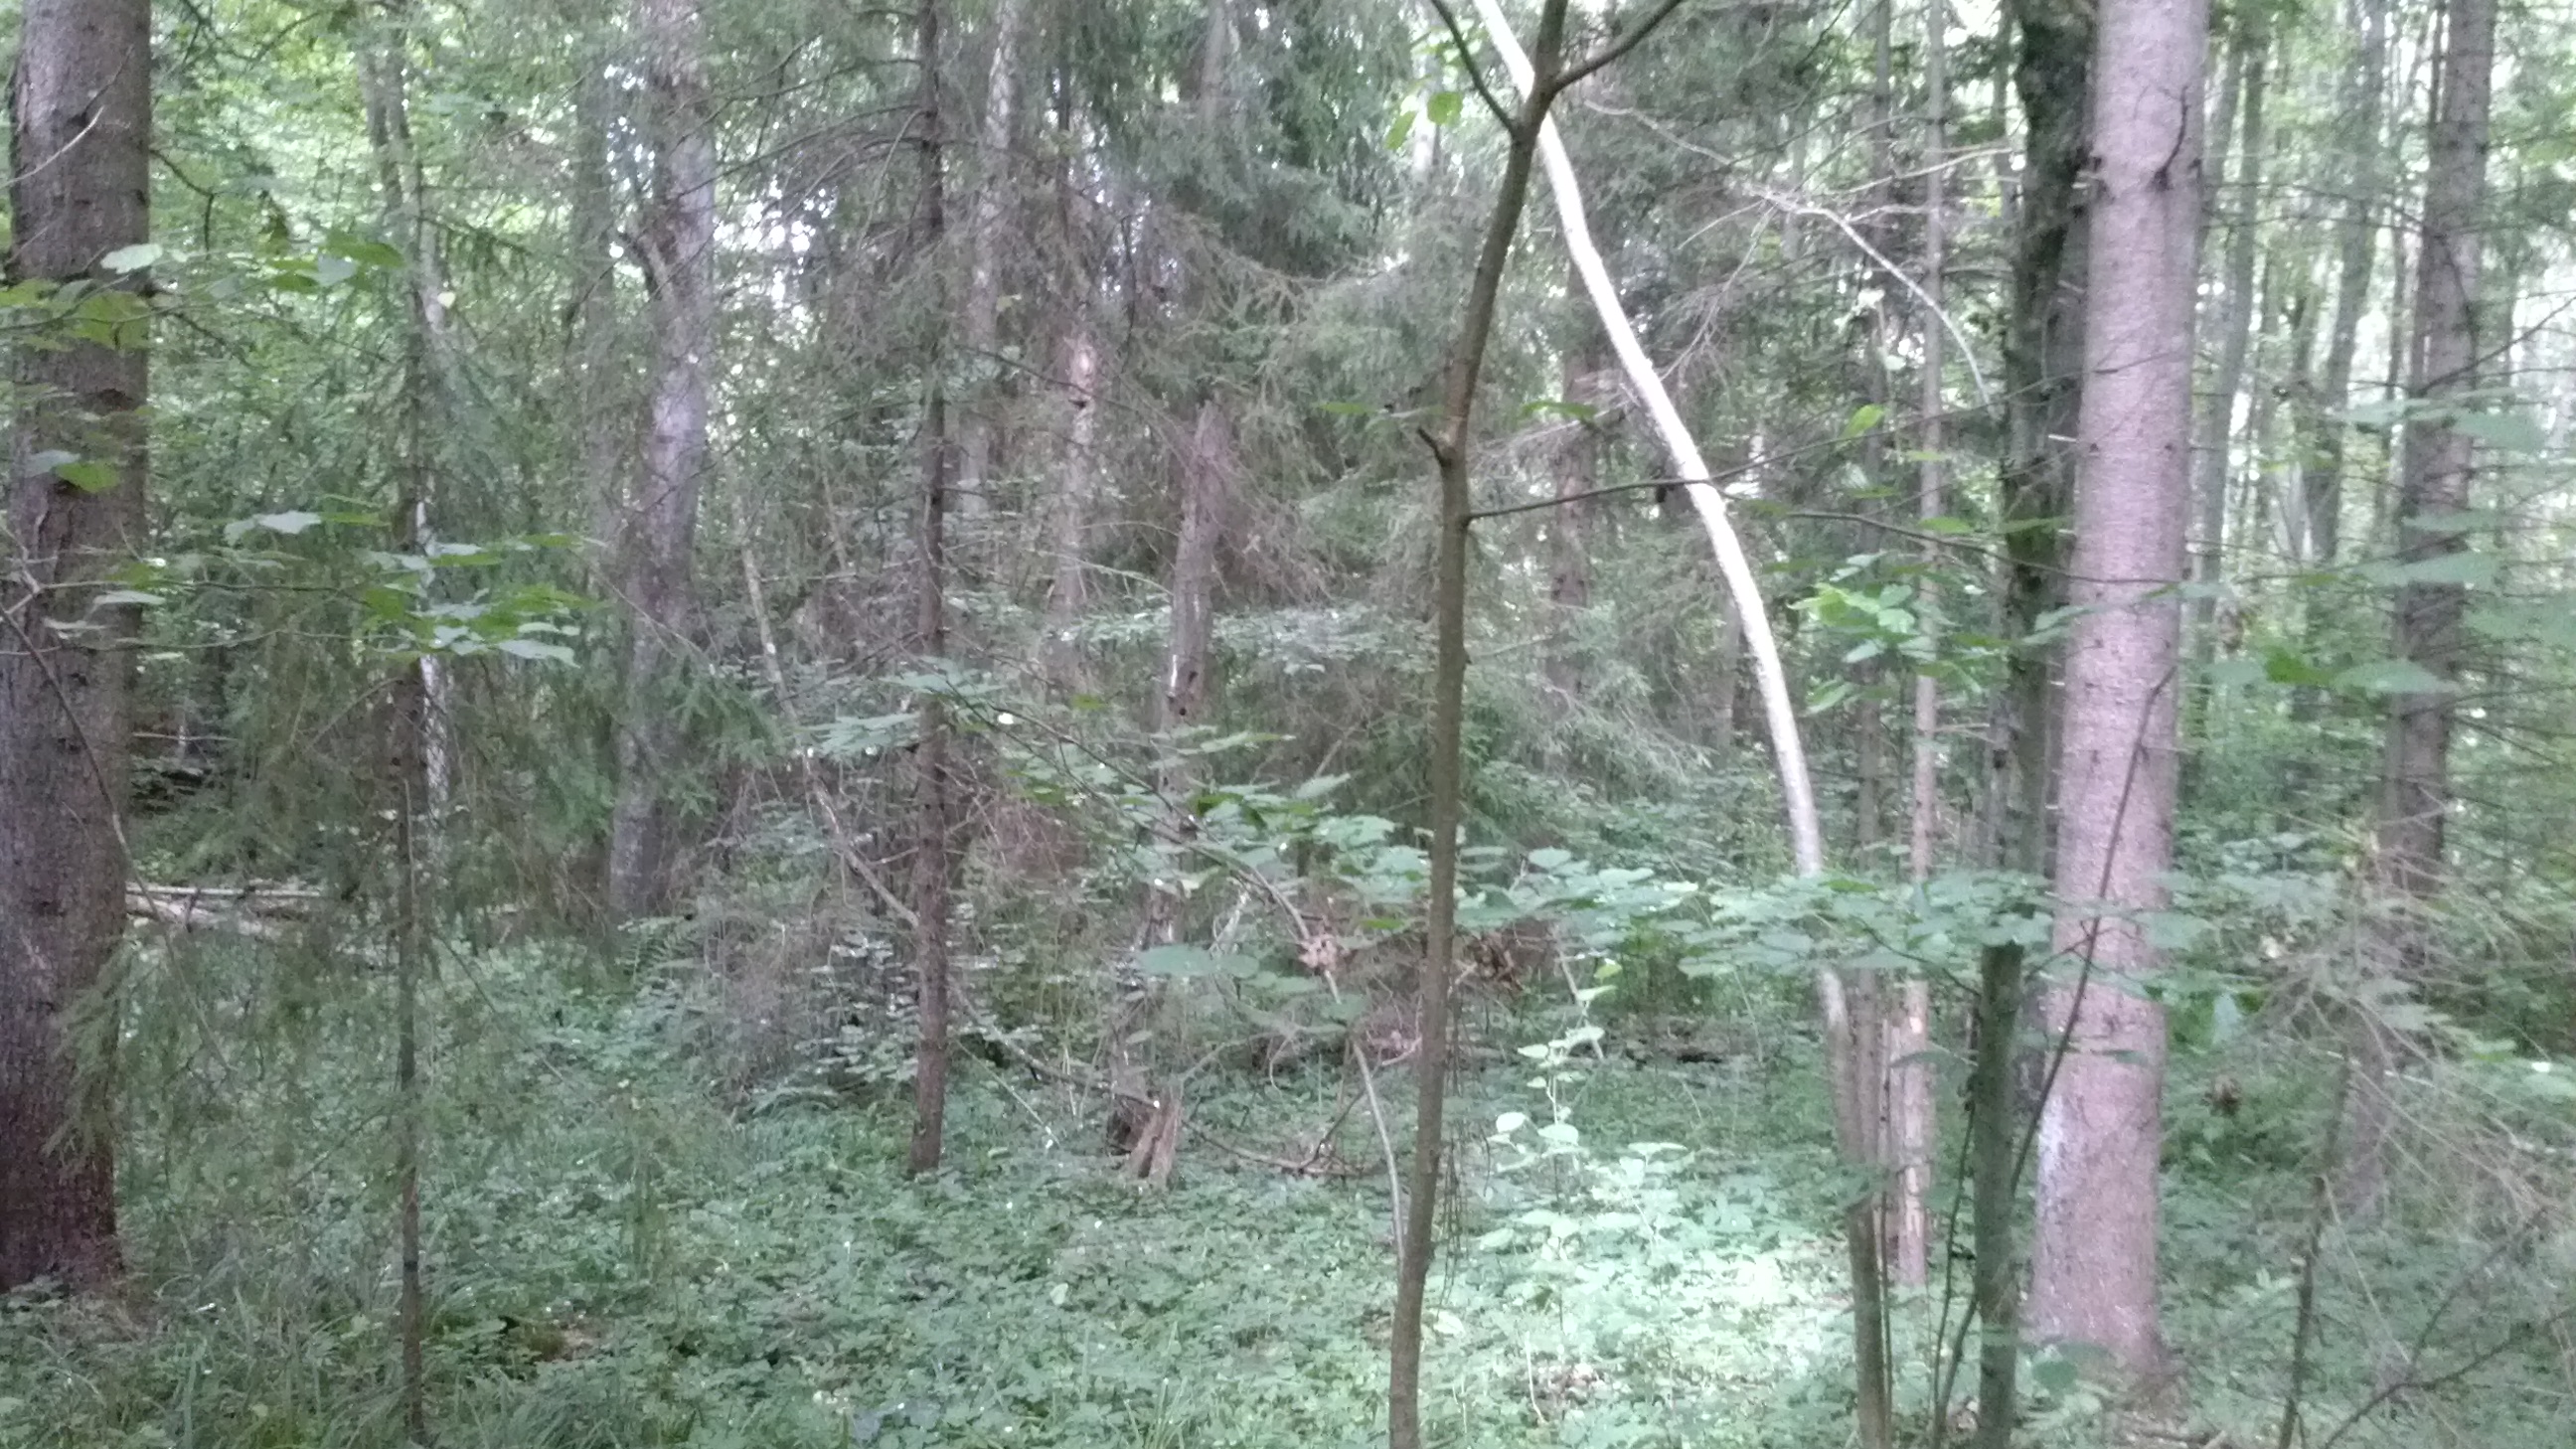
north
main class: Woodland
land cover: Spruce dominated mixed woodland
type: hemiboreal forest and nemoral coniferous forest and mixed broadleaved-coniferous forest
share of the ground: > 75 %
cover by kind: coniferous forest trees 55 %, broadleaved forest trees 30 %, herbaceous plants 10 %, shrubs 5 %
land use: Forestry
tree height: > 5 m
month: June
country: LV
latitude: 56.5784
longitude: 27.7524
